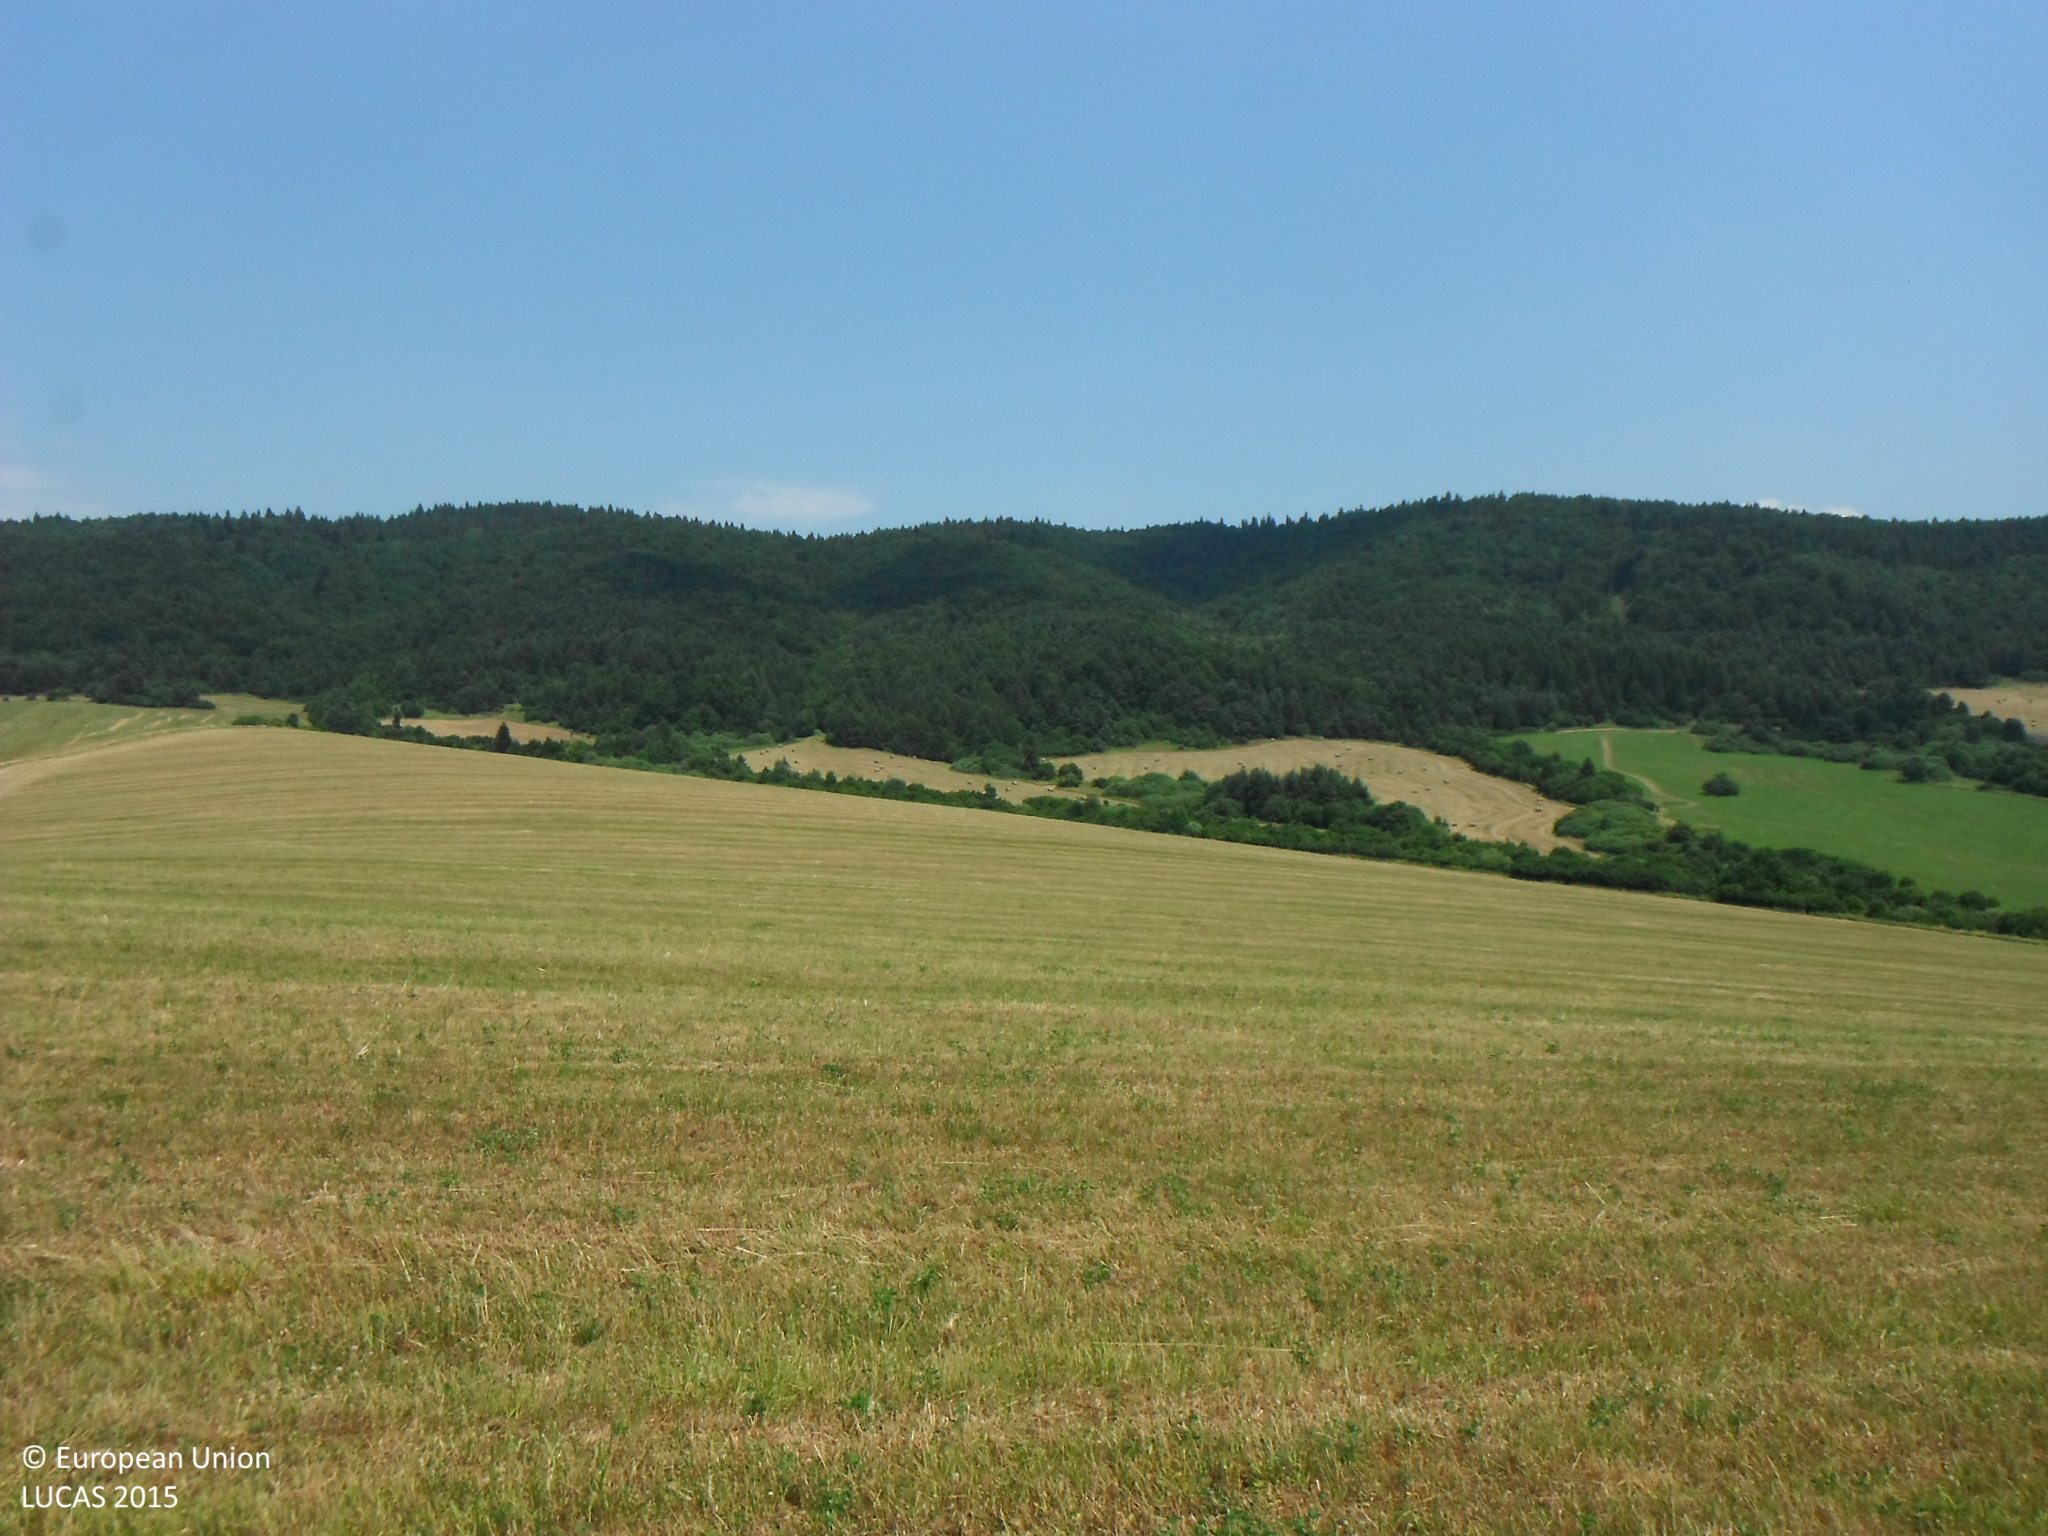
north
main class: Cropland
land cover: Temporary grasslands
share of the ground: > 75 %
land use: Agriculture (excluding fallow land and kitchen gardens)
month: July
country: SK
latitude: 49.1886
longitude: 20.8942
